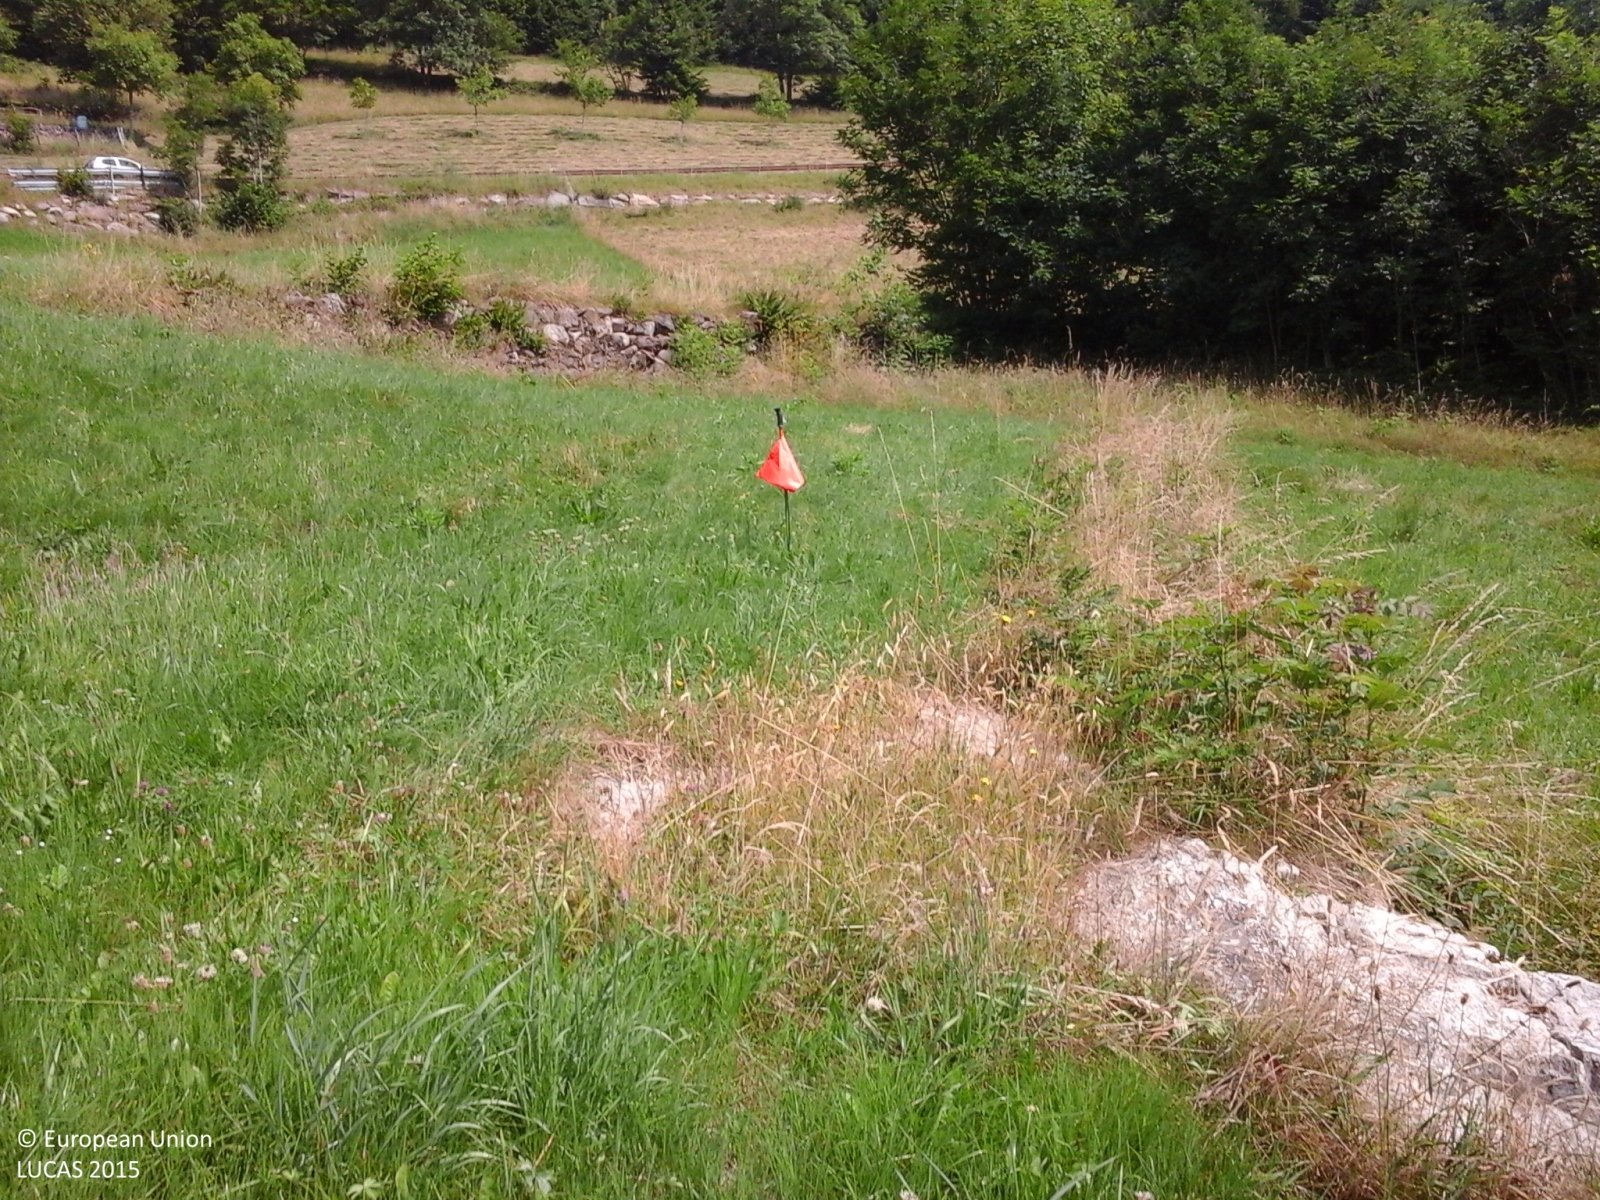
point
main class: Grassland
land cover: Grassland without tree/shrub cover
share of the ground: > 75 %
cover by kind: herbaceous plants 100 %
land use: Agriculture (excluding fallow land and kitchen gardens)
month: July
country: IT
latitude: 45.9548
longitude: 9.9098
